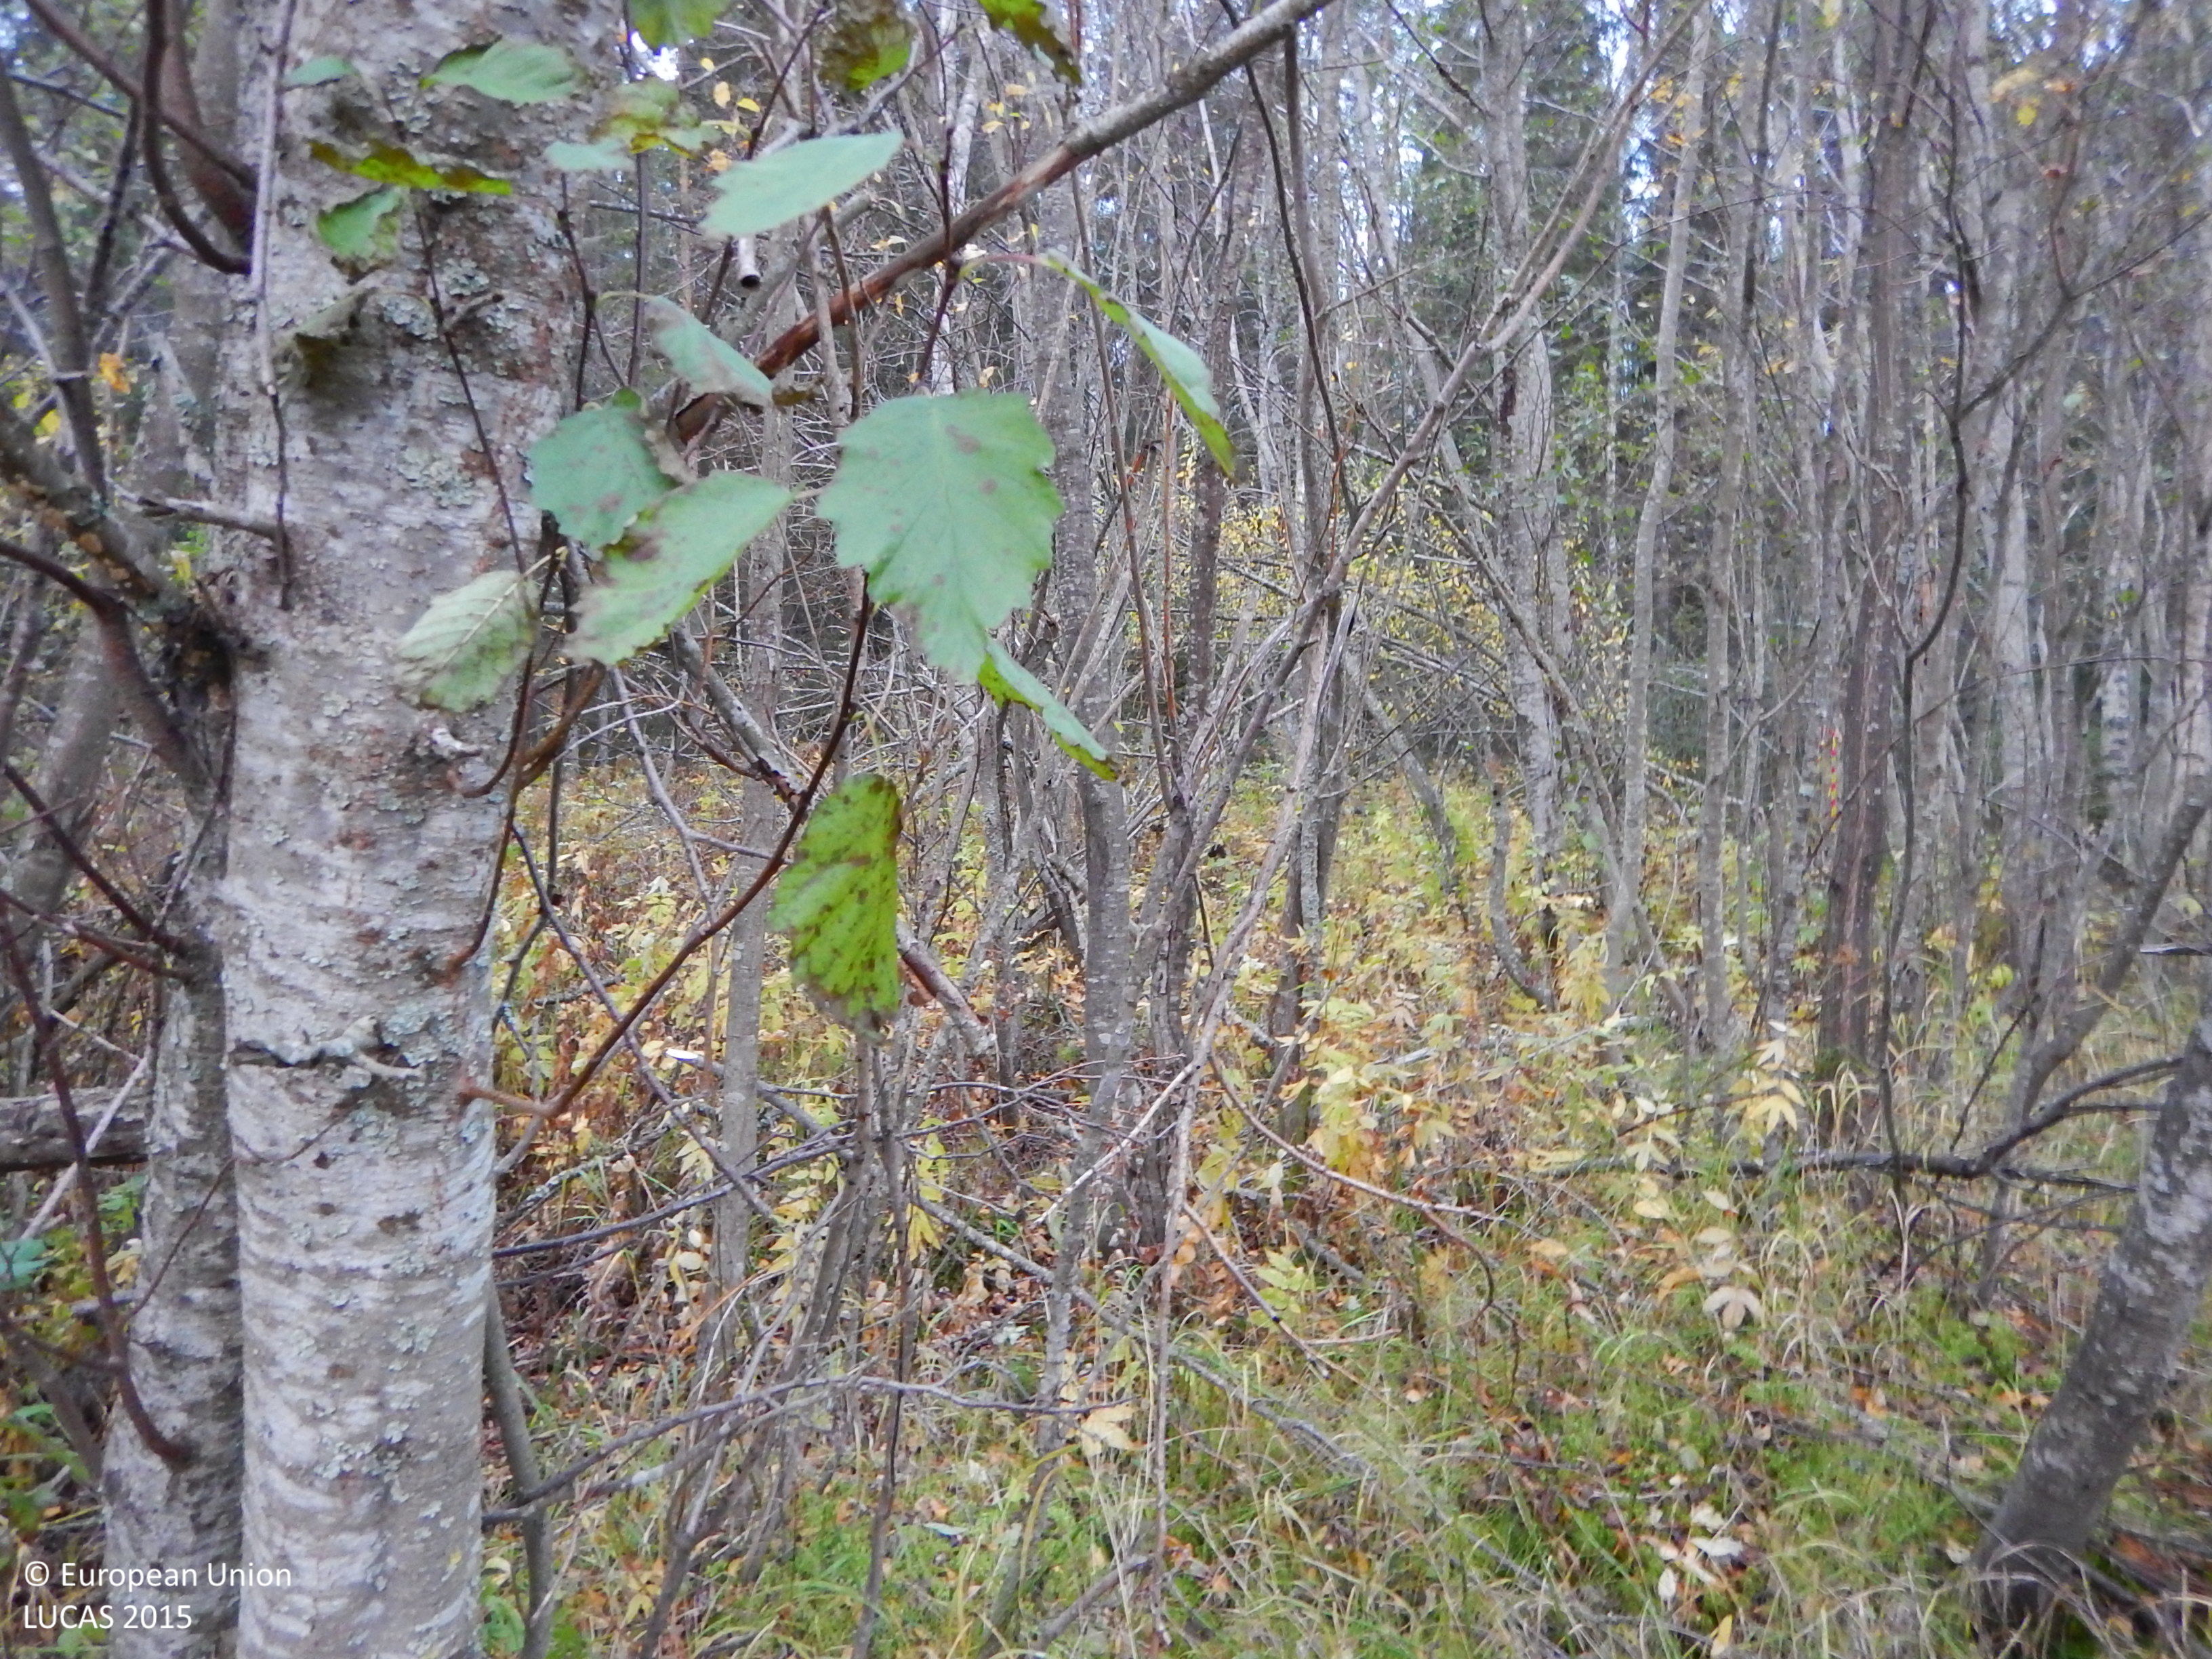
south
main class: Woodland
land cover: Broadleaved woodland
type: non-riverine alder, birch or aspen forest
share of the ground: 50 - 75 %
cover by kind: broadleaved forest trees 55 %, shrubs 20 %, herbaceous plants 10 %, lichens and mosses 10 %, coniferous forest trees 5 %
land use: Semi-natural and natural areas not in use
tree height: > 5 m
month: October
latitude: 64.8548
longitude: 21.0086
